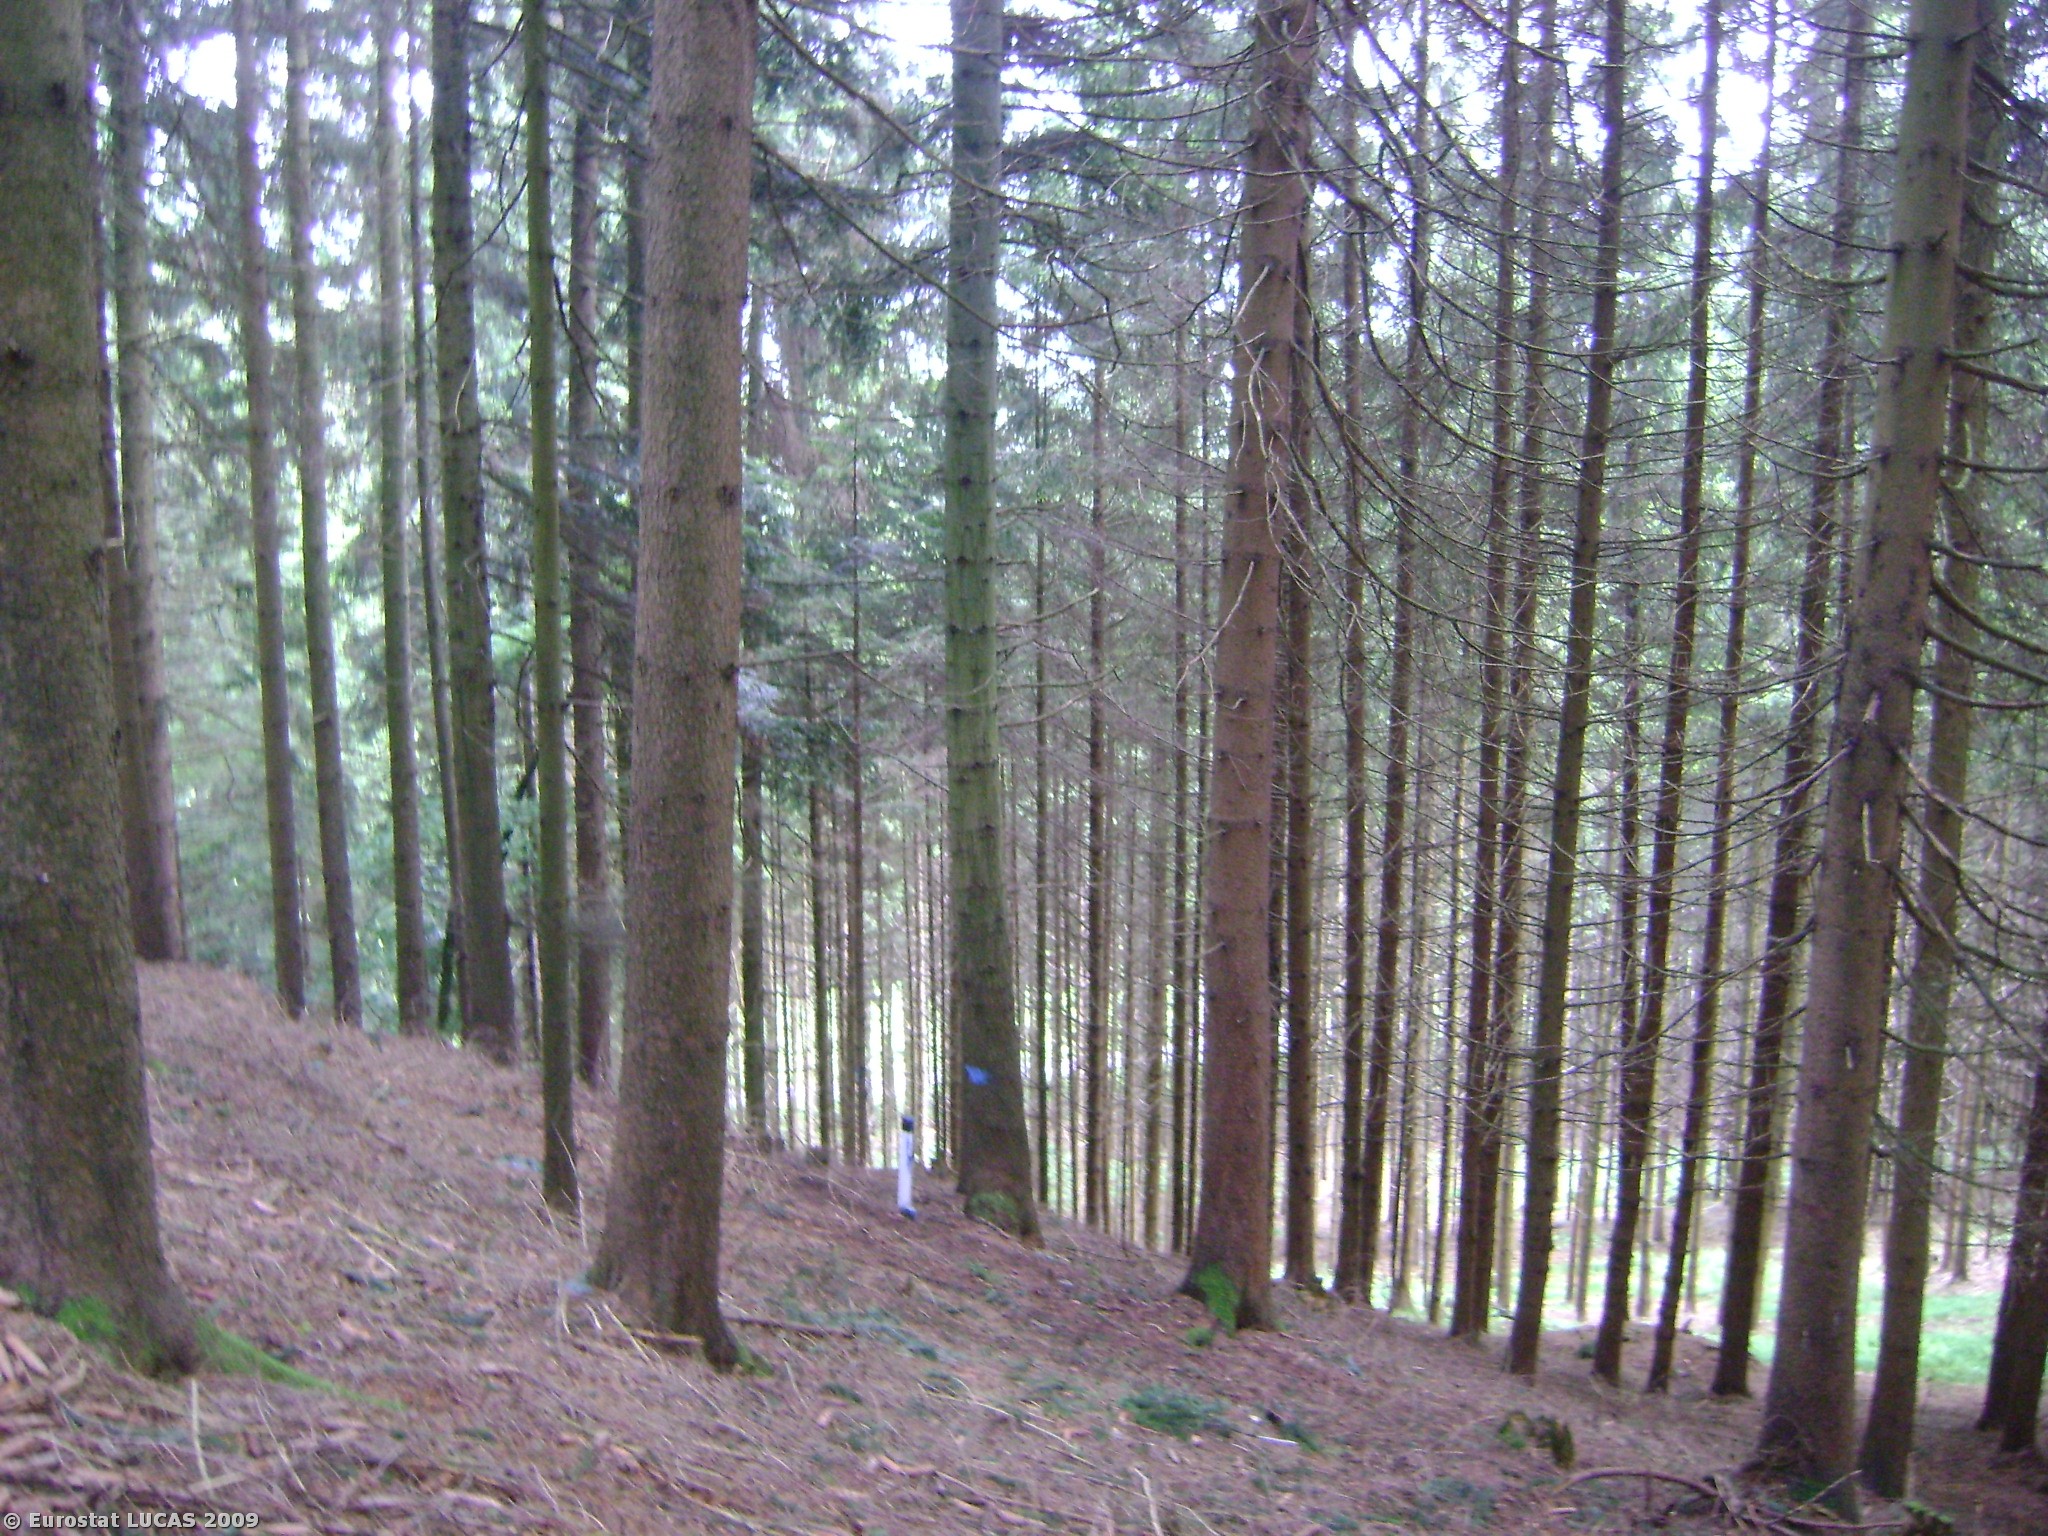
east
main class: Woodland
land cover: Coniferous woodland
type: hemiboreal forest and nemoral coniferous forest and mixed broadleaved-coniferous forest
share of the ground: > 75 %
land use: Forestry
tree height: > 5 m
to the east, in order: Coniferous woodland; Paved roads, cycling and walking lanes; Fences; Grassland without tree/shrub cover; Fences; Shrubland with sparse tree cover; Fences; Grassland without tree/shrub cover; Fences; Grassland without tree/shrub cover
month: May
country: AT
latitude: 47.9602
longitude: 13.2264
